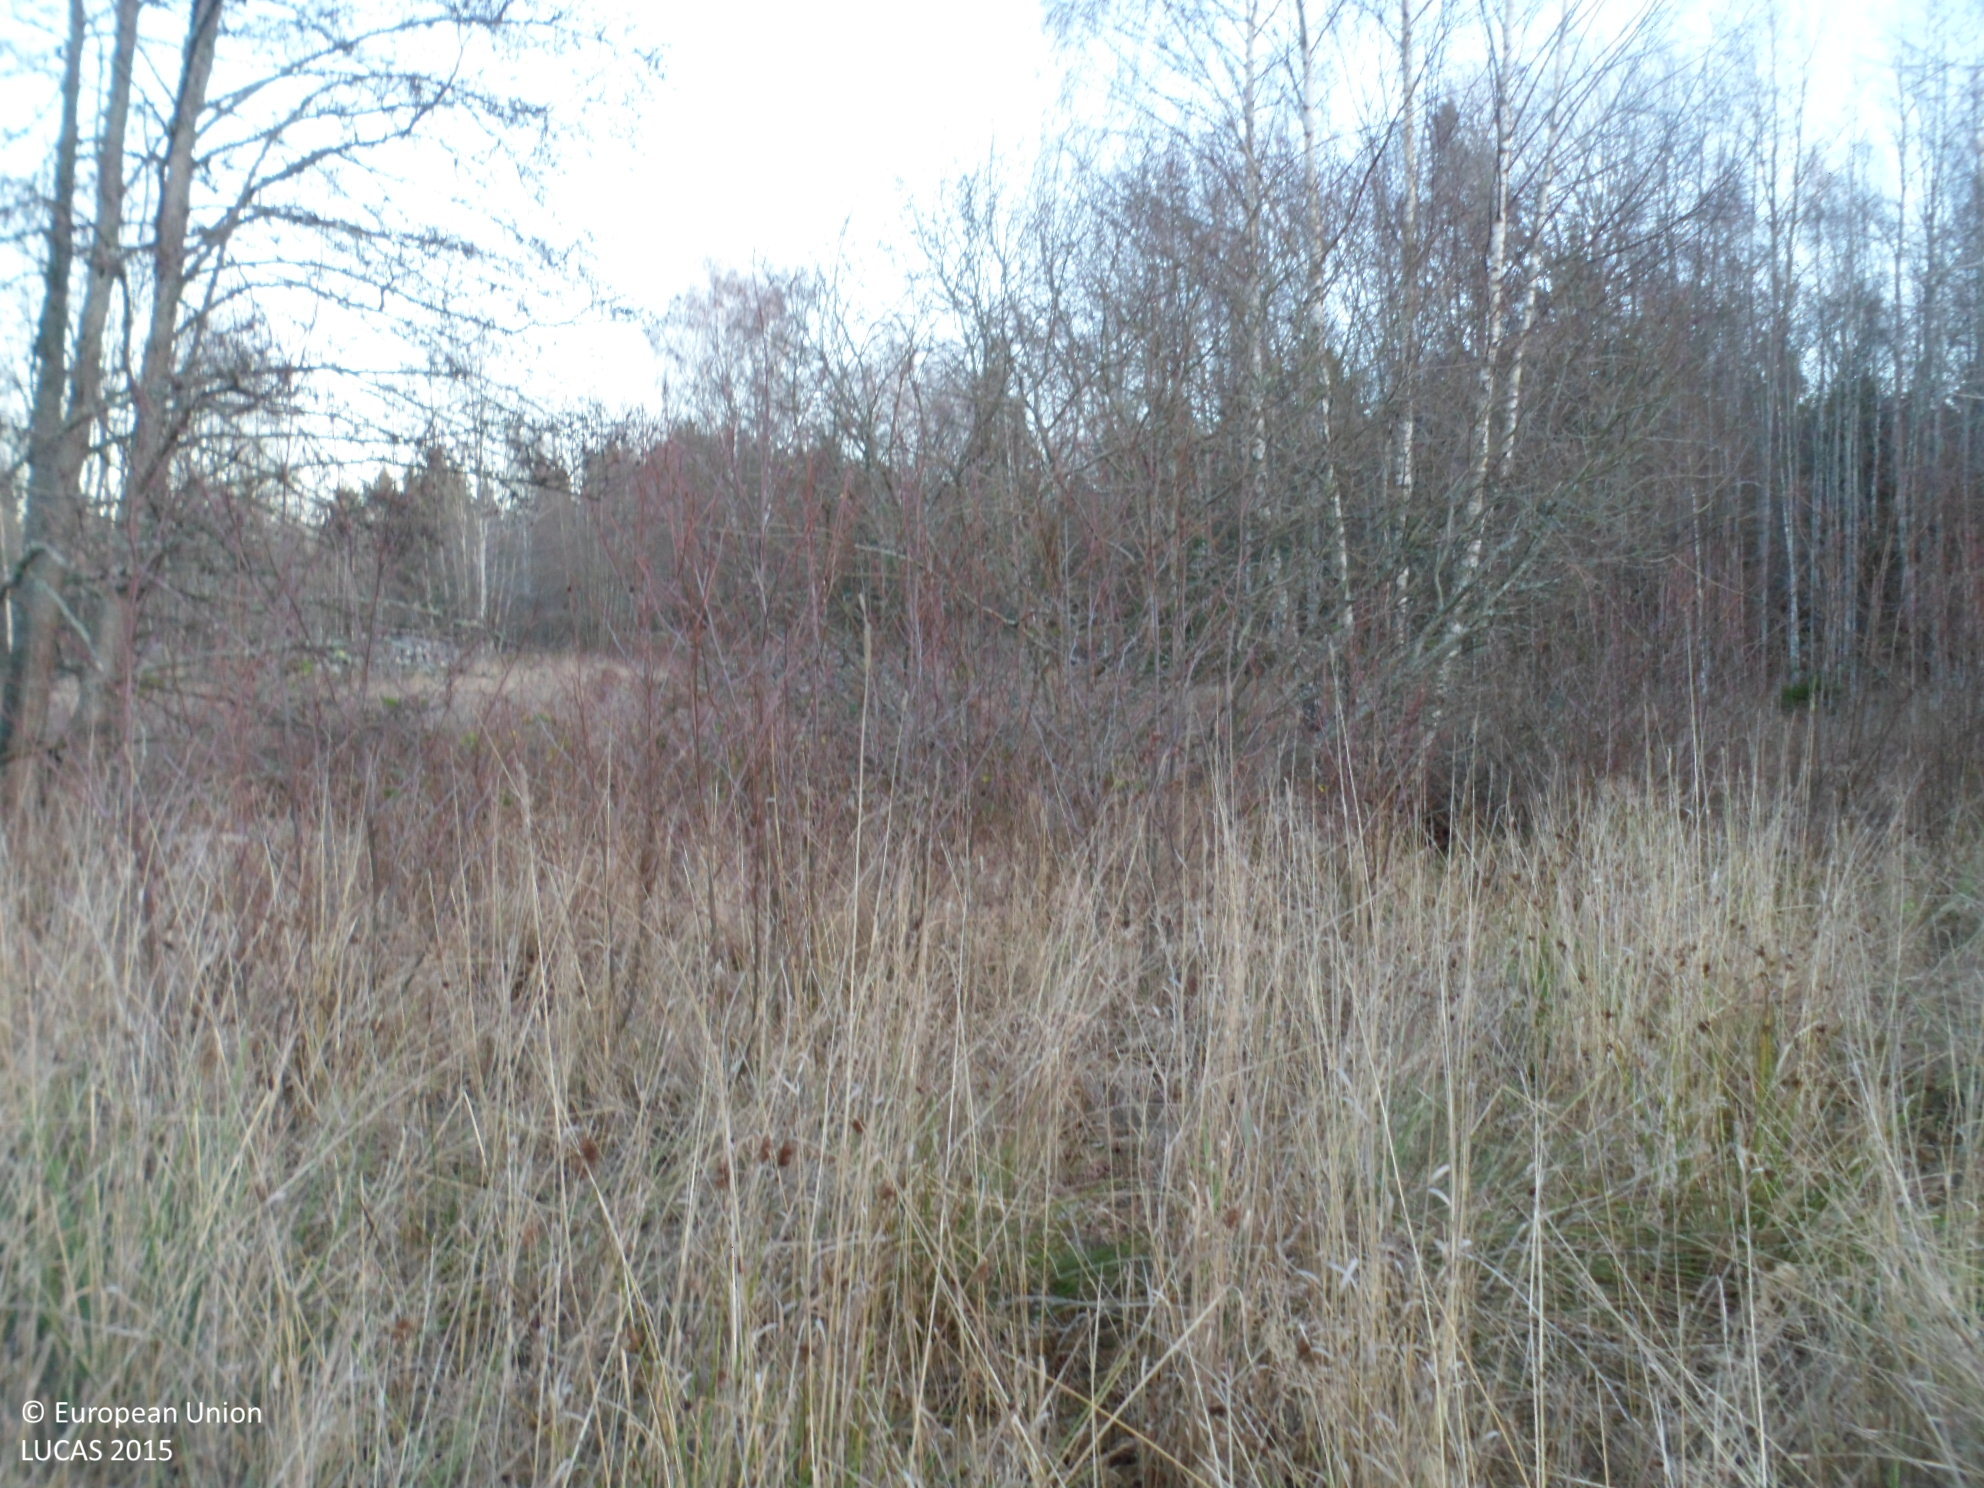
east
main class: Grassland
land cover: Grassland with sparse tree/shrub cover
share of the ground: > 75 %
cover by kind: herbaceous plants 90 %, broadleaved forest trees 5 %, shrubs 5 %
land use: Agriculture (excluding fallow land and kitchen gardens)
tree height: < 5 m
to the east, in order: Grassland with sparse tree/shrub cover; Broadleaved woodland; Ditches and canals; Fences; Grassland with sparse tree/shrub cover; Broadleaved woodland; Dry stone walls; Broadleaved woodland; Spruce dominated mixed woodland; Dry stone walls; Grassland without tree/shrub cover; Dry stone walls; Spruce dominated mixed woodland; Spruce dominated coniferous woodland
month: November
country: SE
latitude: 56.8162
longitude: 16.1431
